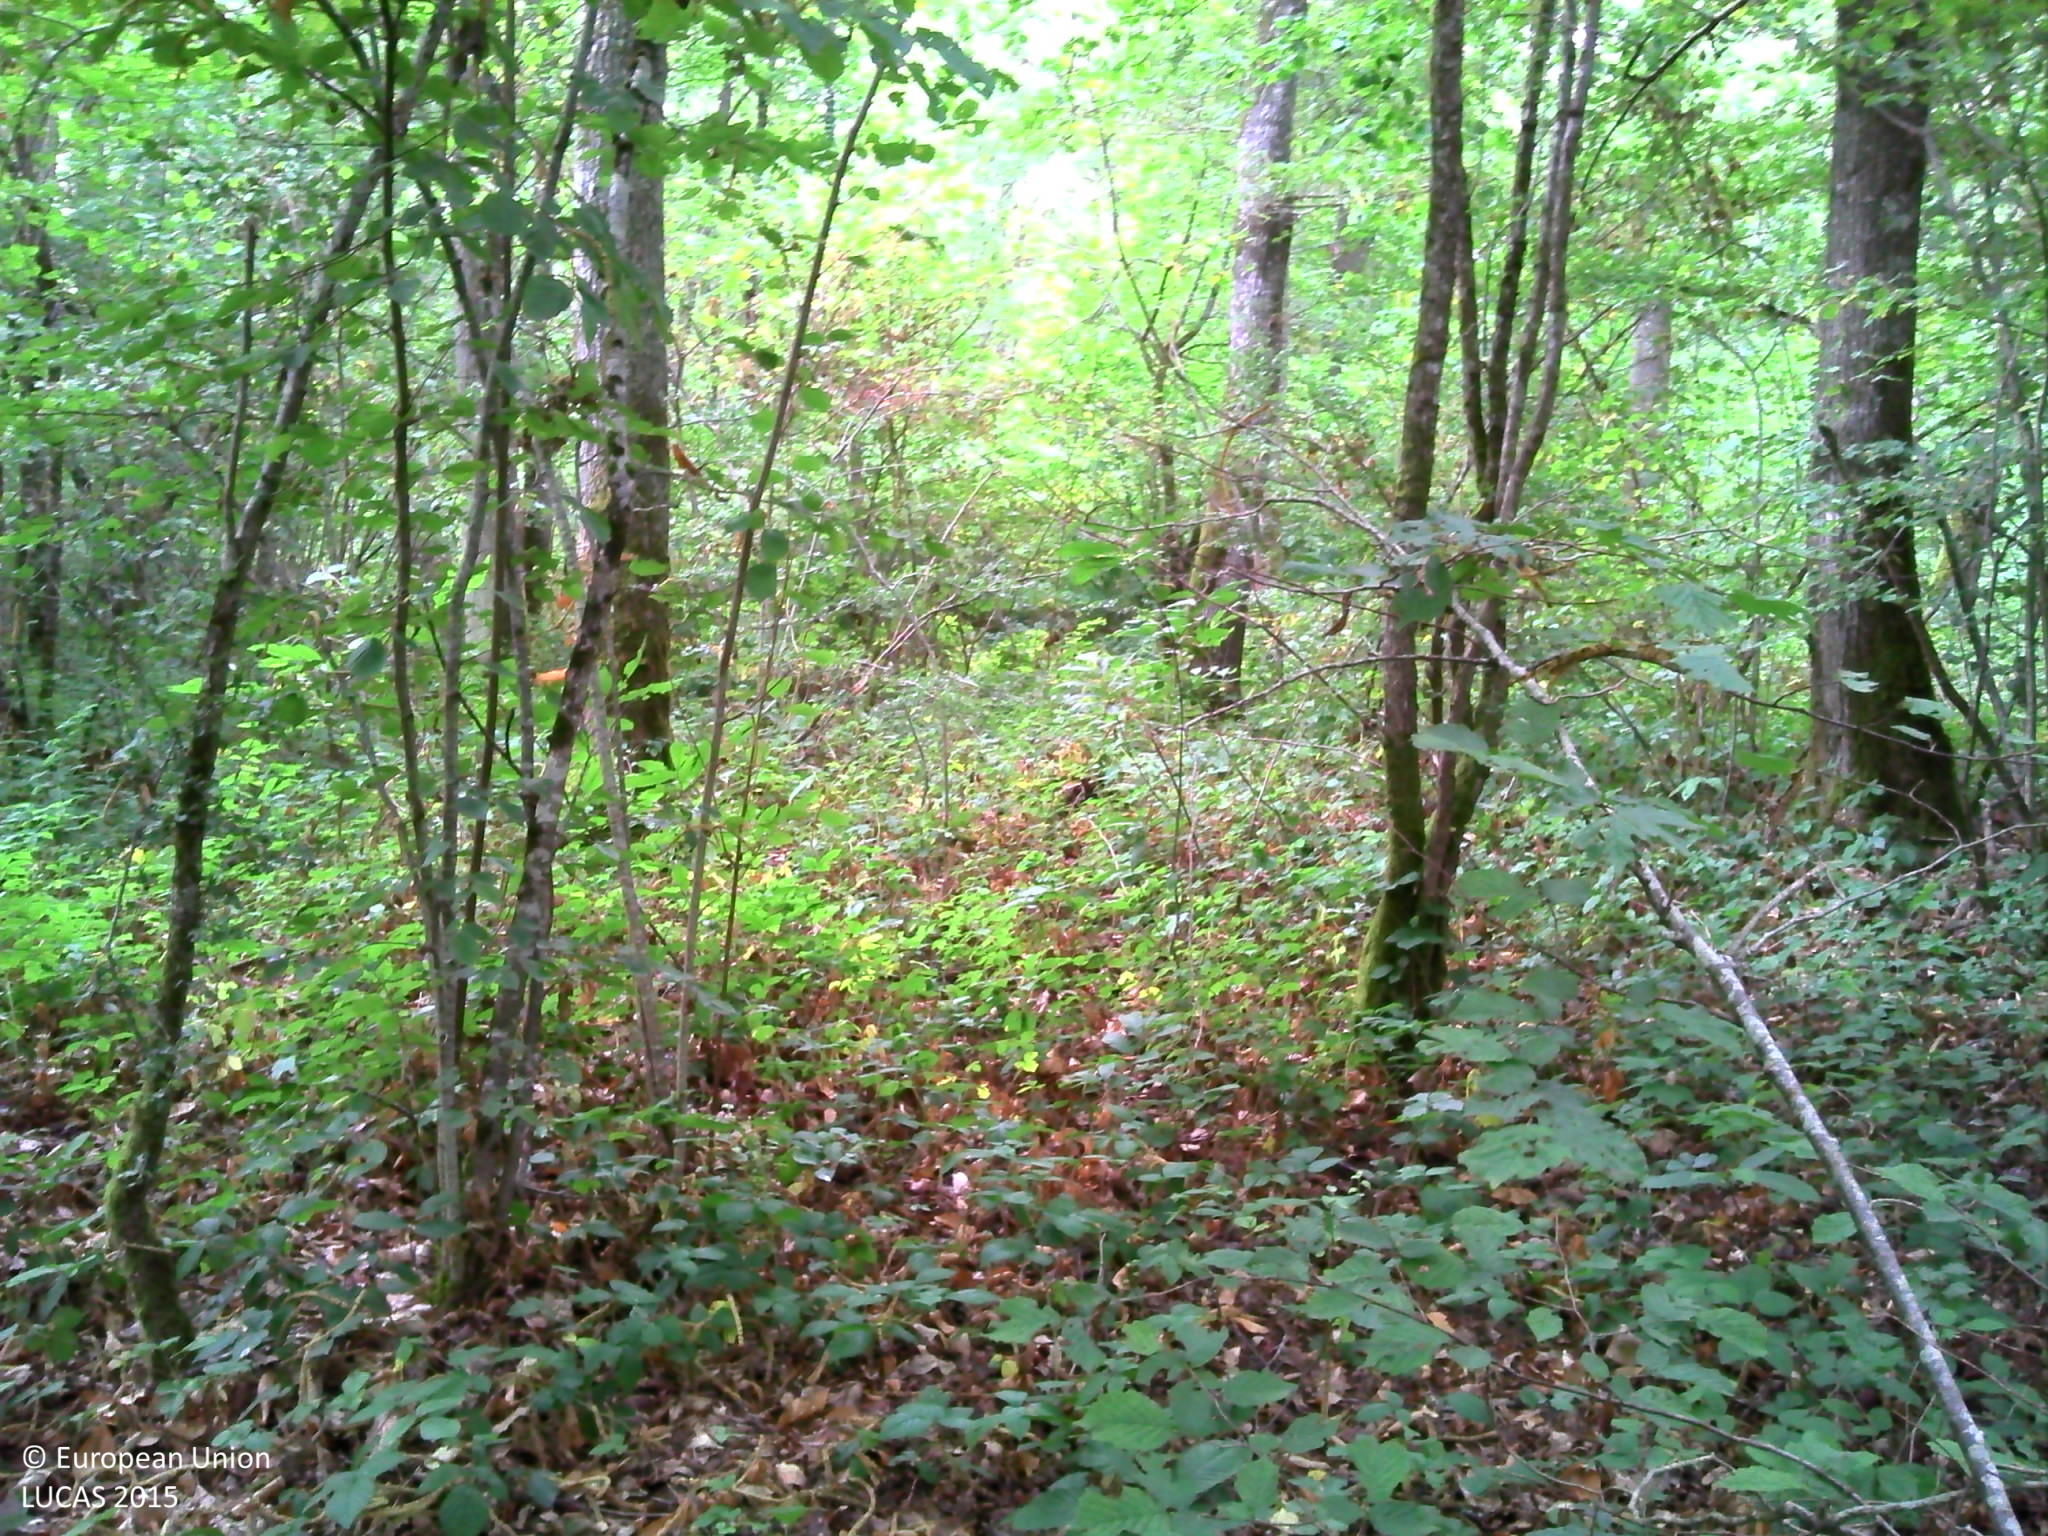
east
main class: Woodland
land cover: Broadleaved woodland
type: mesophytic deciduous forest
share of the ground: > 75 %
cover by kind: broadleaved forest trees 90 %, herbaceous plants 5 %, lichens and mosses 5 %
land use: Forestry
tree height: > 5 m
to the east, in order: Broadleaved woodland; Tracks; Broadleaved woodland; Grass margins; Tracks; Grass margins; Broadleaved woodland
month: July
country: FR
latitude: 48.1354
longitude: 3.4233
